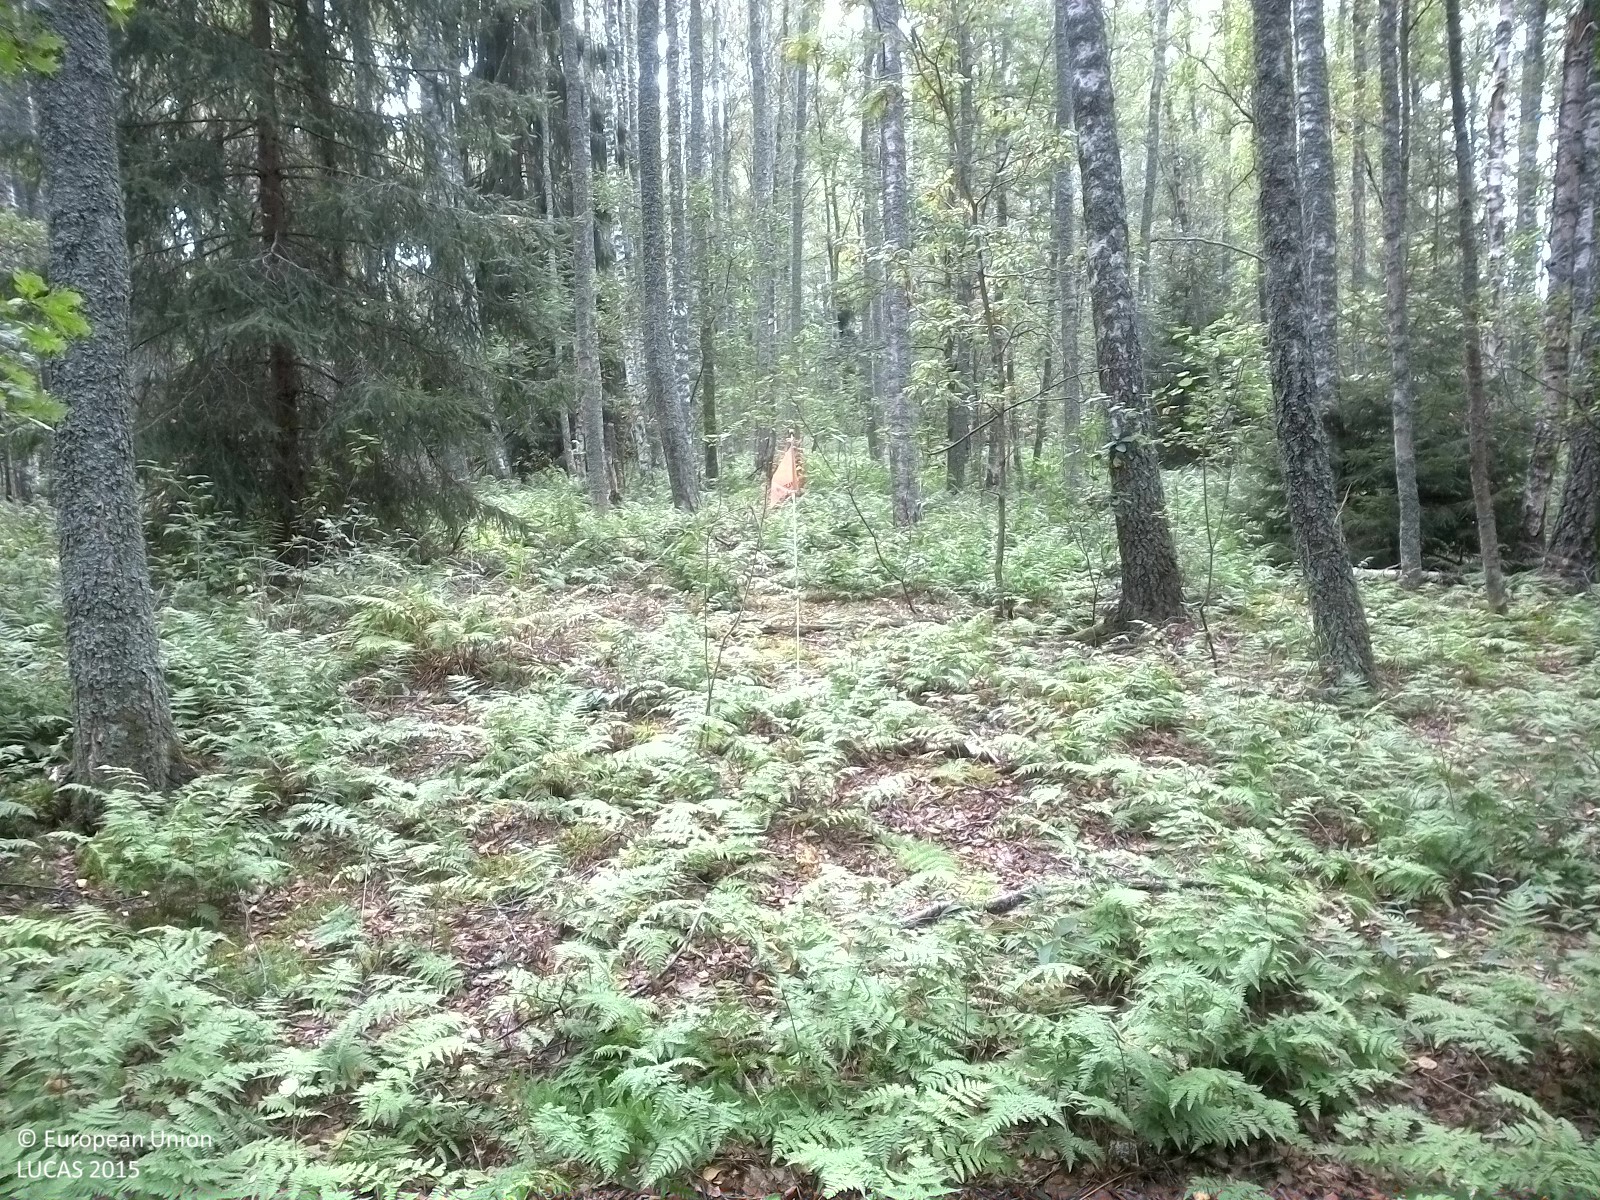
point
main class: Woodland
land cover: Broadleaved woodland
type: hemiboreal forest and nemoral coniferous forest and mixed broadleaved-coniferous forest
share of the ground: 25 - 50 %
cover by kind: broadleaved forest trees 35 %, herbaceous plants 35 %, unconsolidated bare surface 20 %, coniferous forest trees 5 %, lichens and mosses 5 %
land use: Forestry
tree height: > 5 m
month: August
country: SE
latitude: 59.3001
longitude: 15.8749
